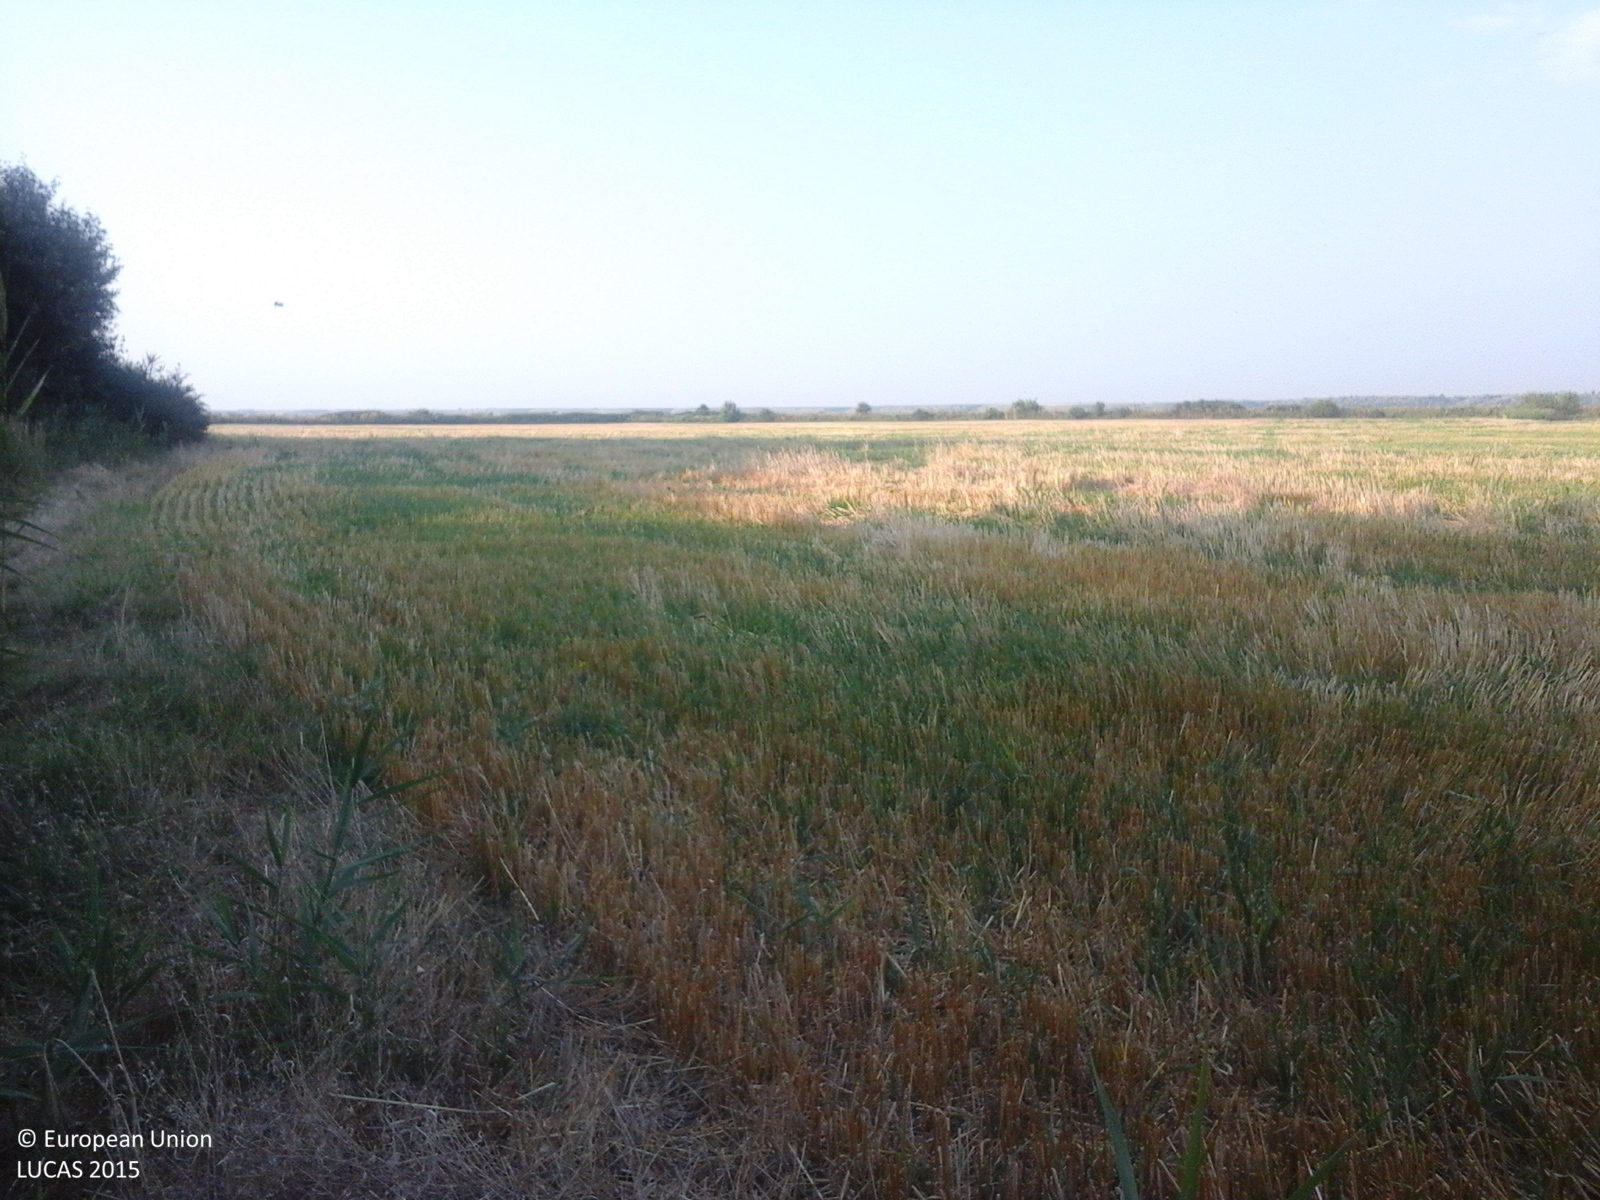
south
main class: Woodland
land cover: Broadleaved woodland
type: floodplain forest
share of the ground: > 75 %
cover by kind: broadleaved forest trees 100 %
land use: Forestry
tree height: > 5 m
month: July
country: RO
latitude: 44.5795
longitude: 27.0707
